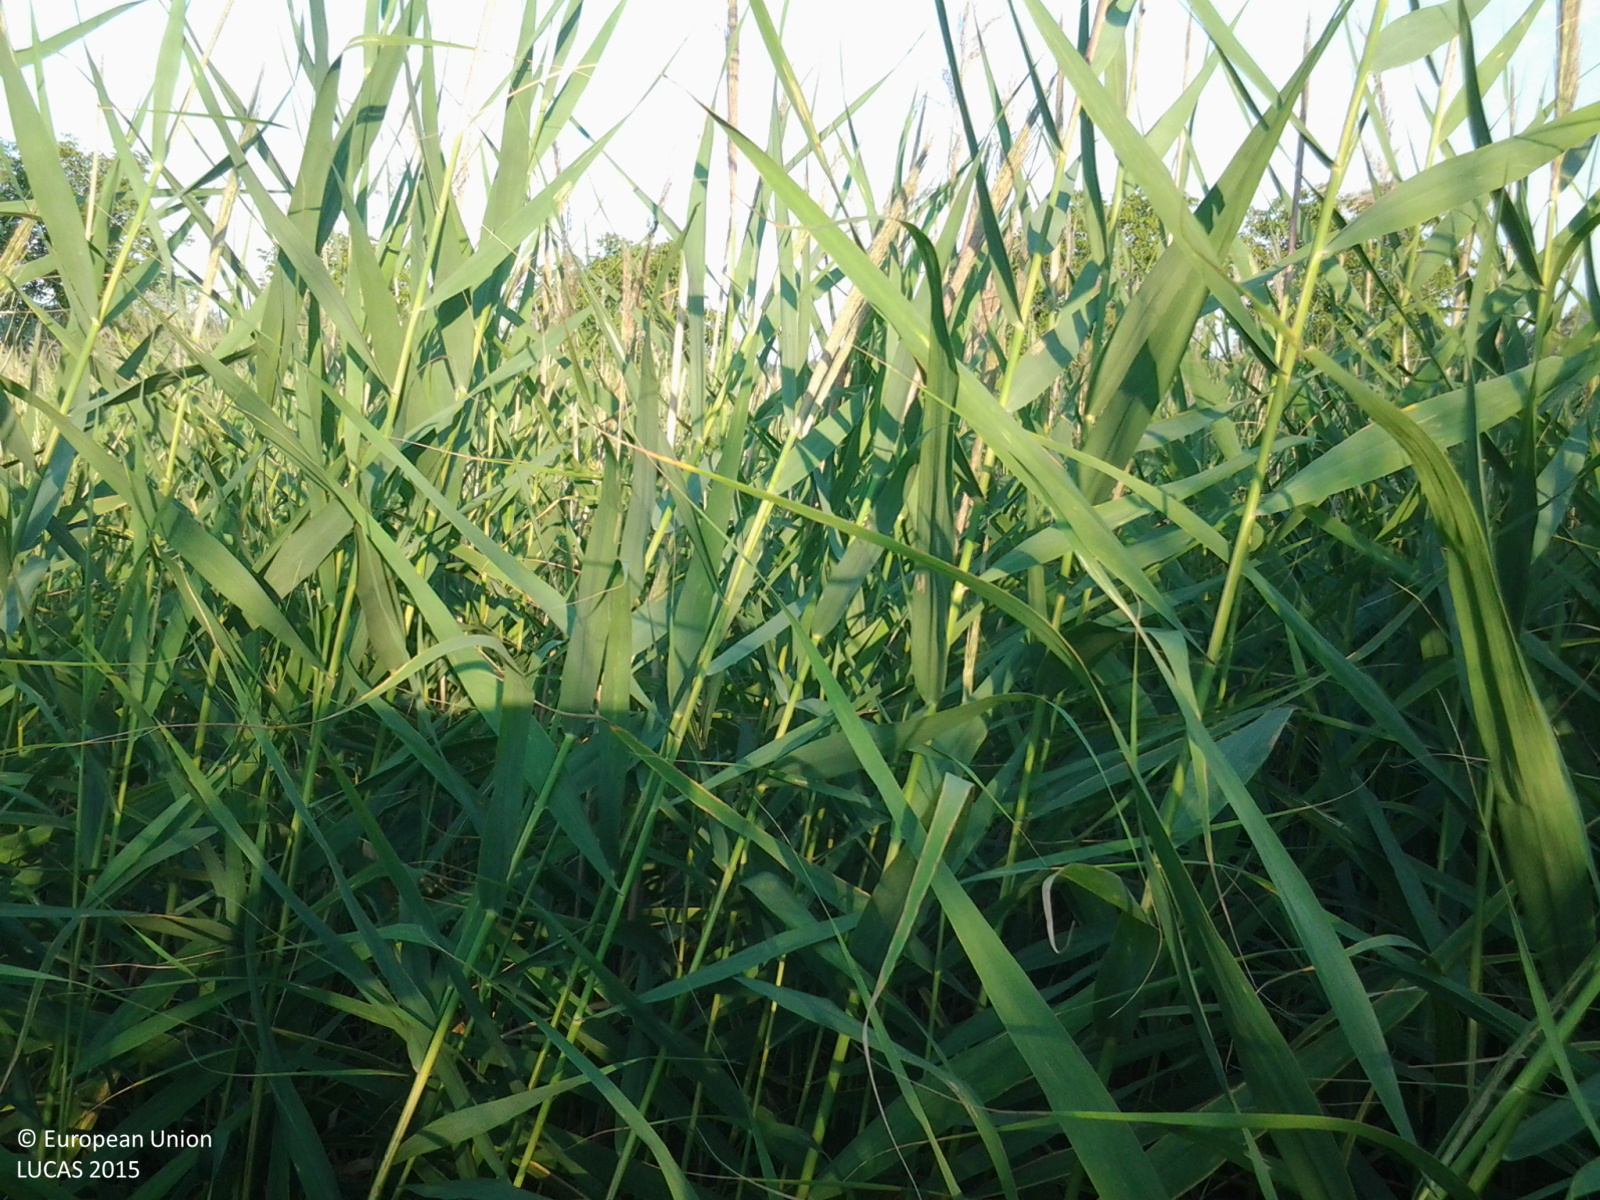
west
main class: Grassland
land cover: Spontaneously vegetated surfaces
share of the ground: > 75 %
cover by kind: herbaceous plants 100 %
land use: Semi-natural and natural areas not in use
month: August
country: HU
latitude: 46.8815
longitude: 21.6017
